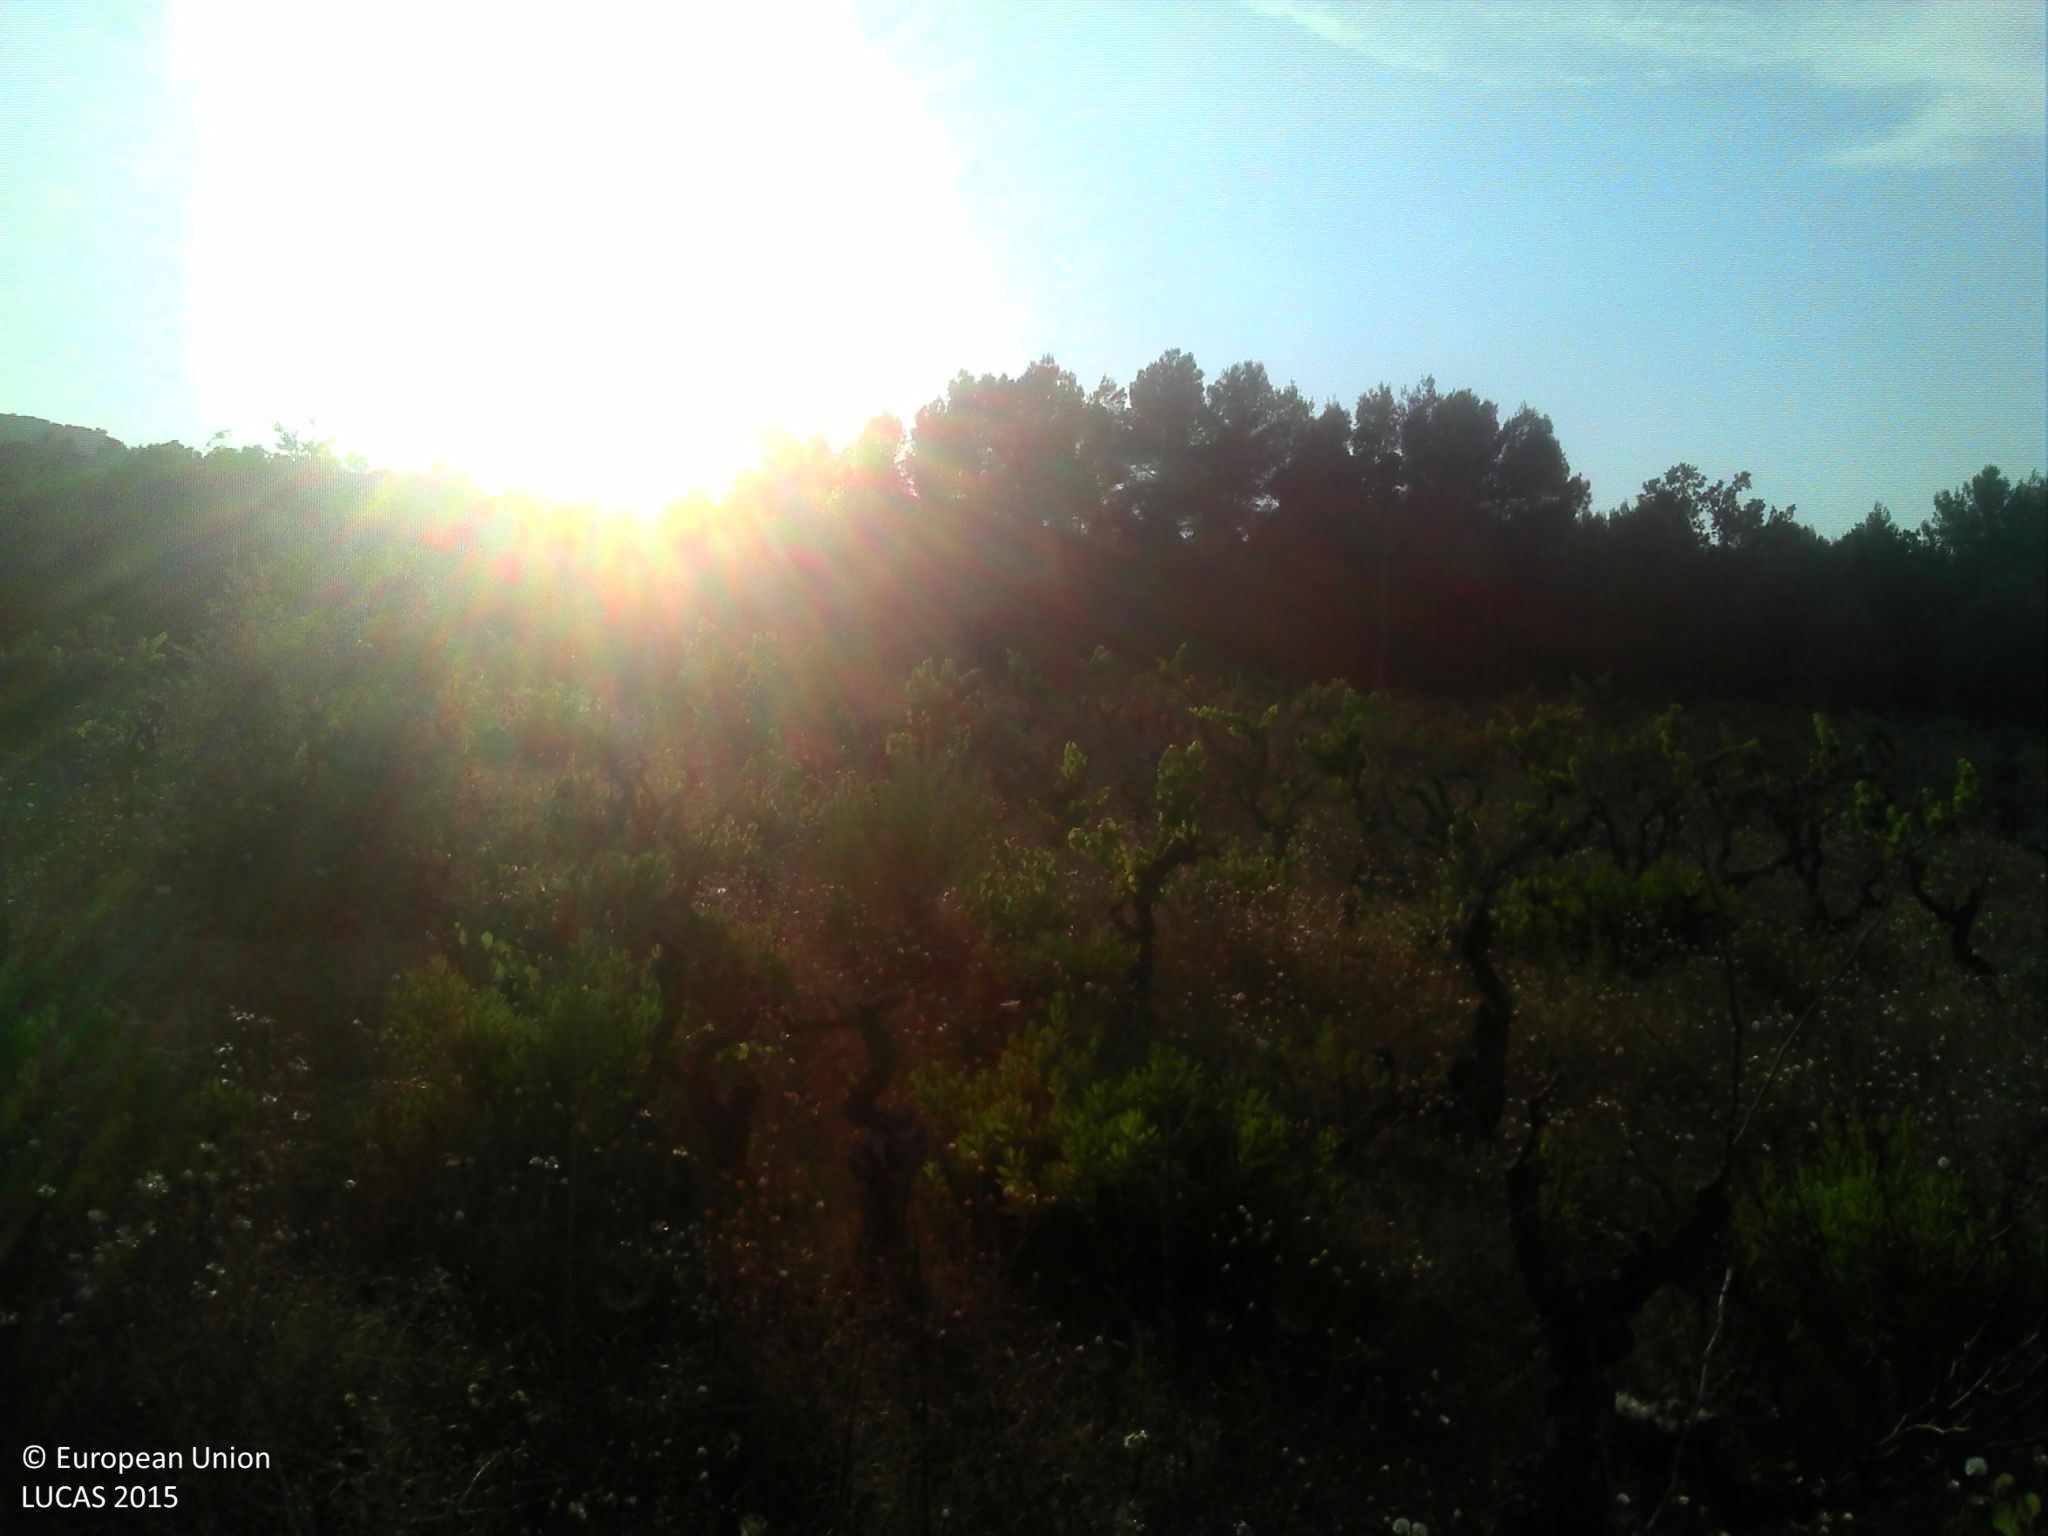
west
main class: Cropland
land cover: Vineyards
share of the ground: 25 - 50 %
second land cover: Grassland without tree/shrub cover
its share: > 75 %
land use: Abandoned areas
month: July
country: FR
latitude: 43.4192
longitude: 6.3407
